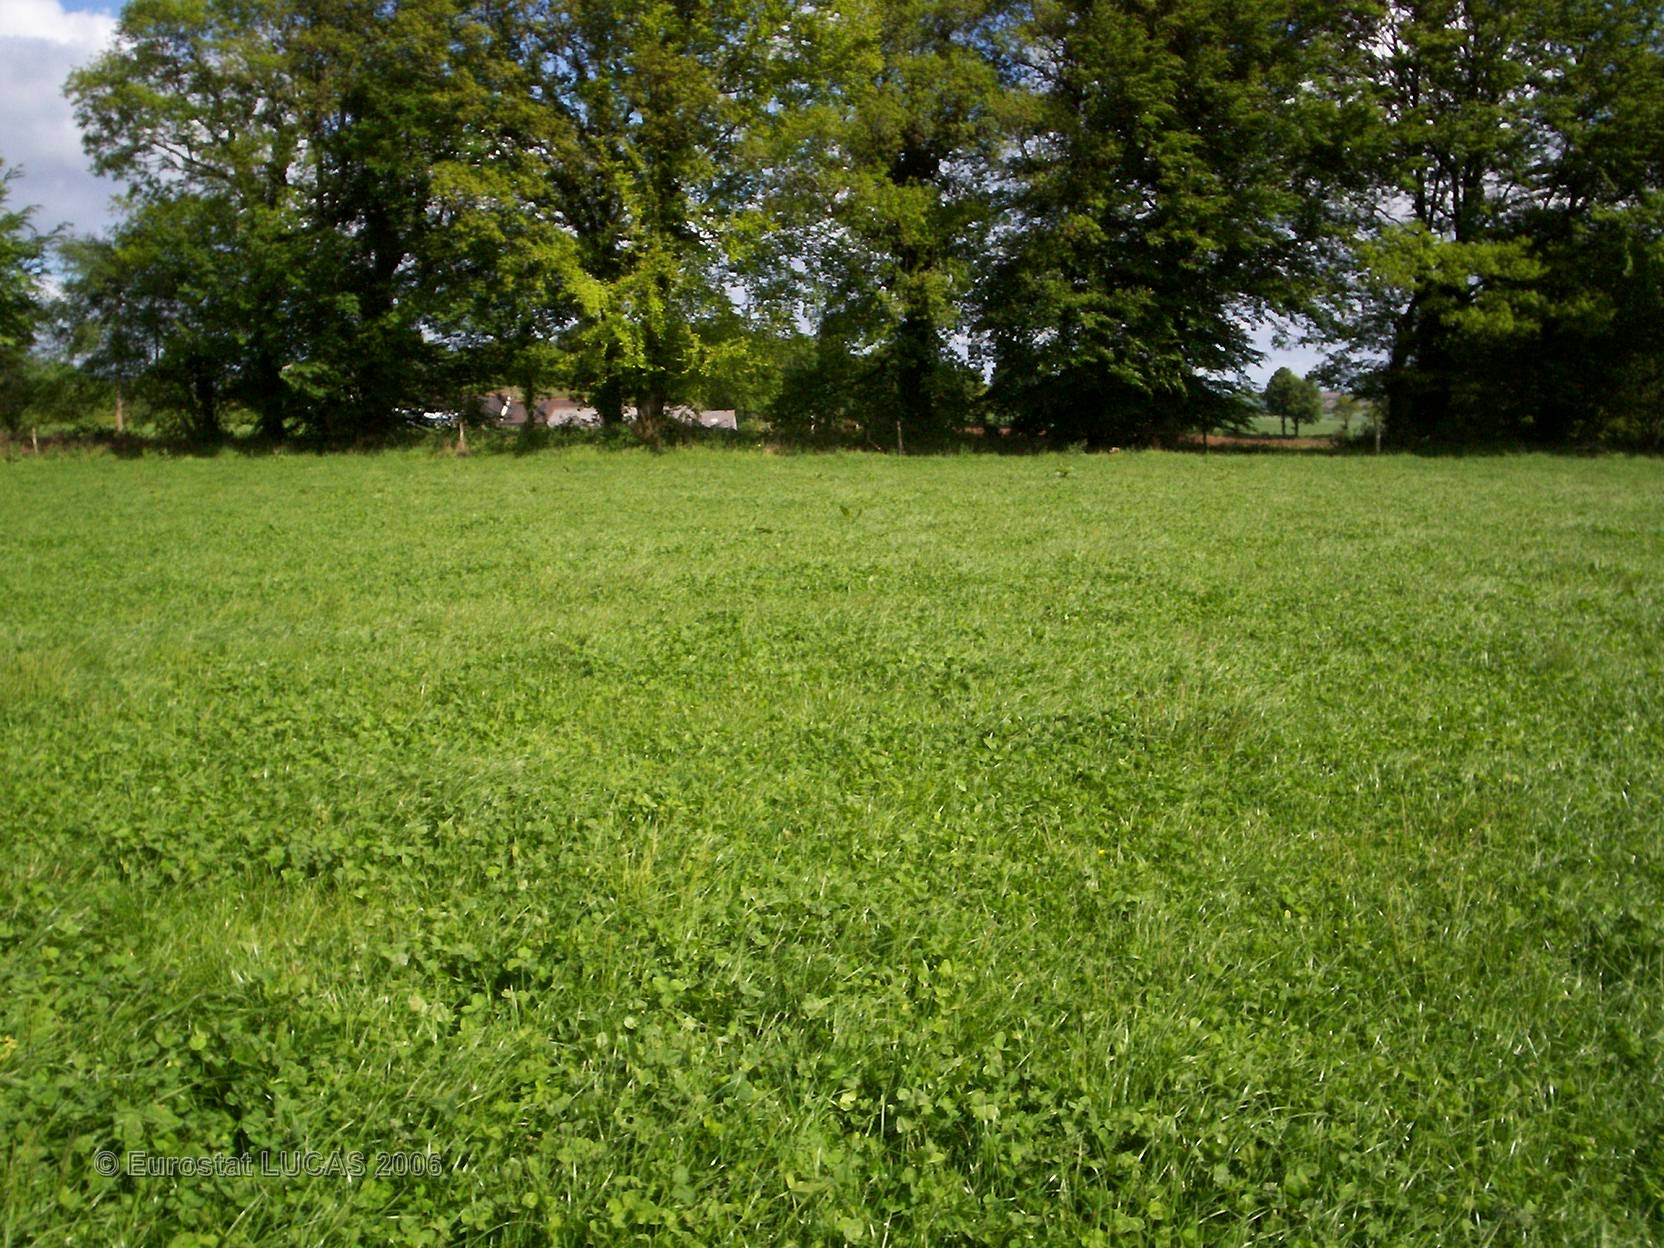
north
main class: Cropland
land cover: Clovers
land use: Agriculture (excluding fallow land and kitchen gardens)
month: May
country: FR
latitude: 48.2534
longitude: -2.9850
